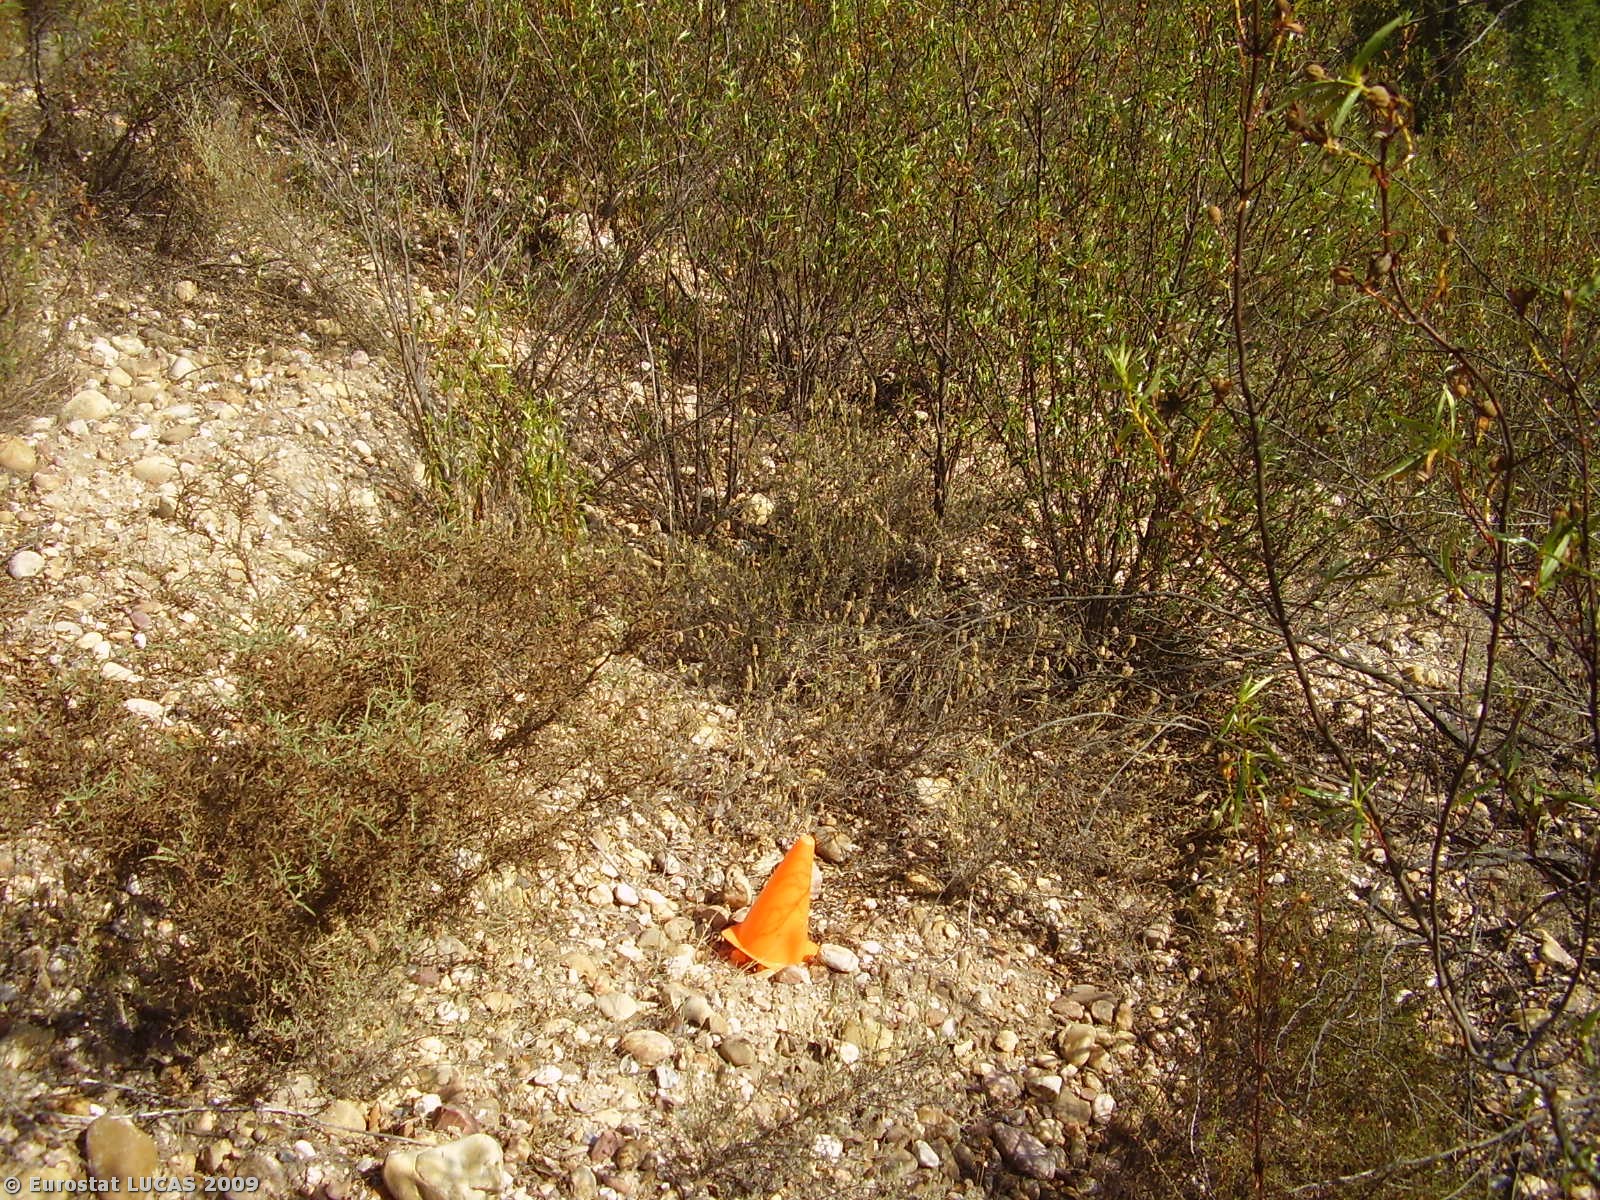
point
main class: Woodland
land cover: Broadleaved woodland
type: broadleaved evergreen forest
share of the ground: 10 - 25 %
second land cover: Shrubland with sparse tree cover
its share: > 75 %
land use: Forestry
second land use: Fallow land
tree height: > 5 m
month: July
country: PT
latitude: 39.4095
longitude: -8.0488
